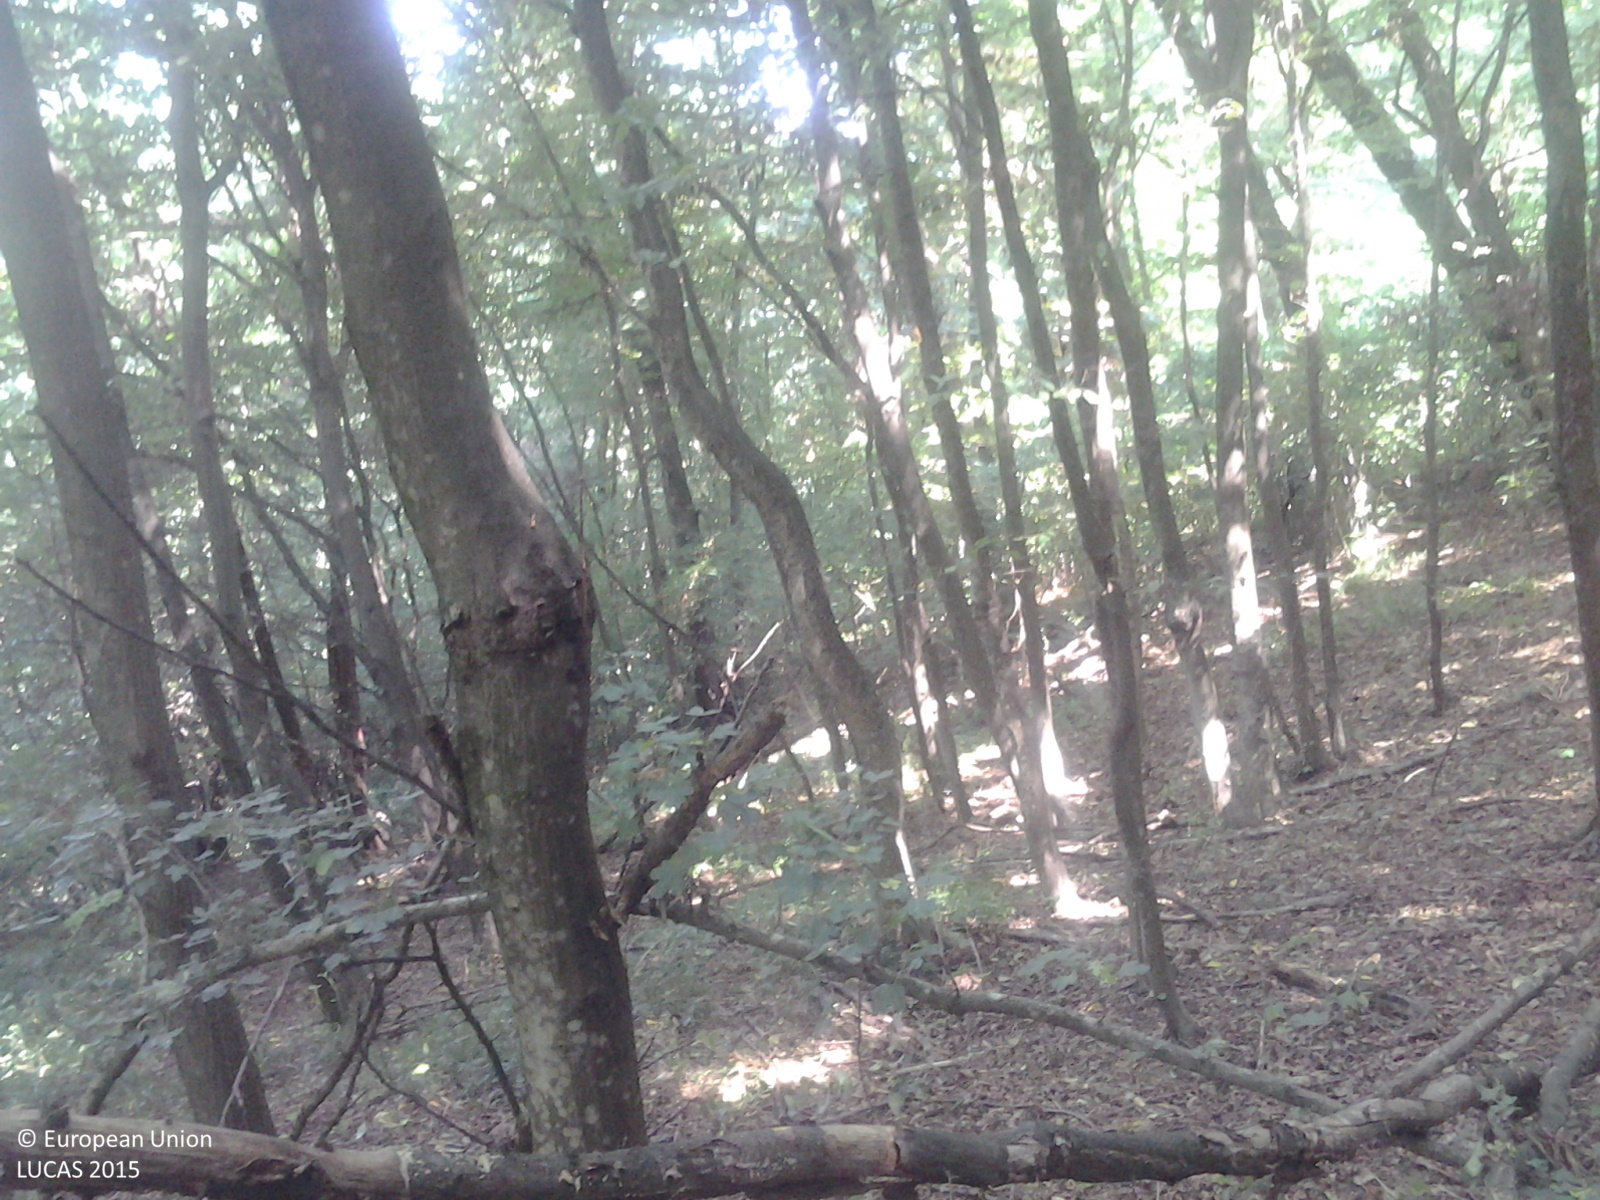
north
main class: Woodland
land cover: Broadleaved woodland
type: beech forest
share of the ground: > 75 %
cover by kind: broadleaved forest trees 100 %
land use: Forestry
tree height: > 5 m
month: August
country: HU
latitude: 46.5679
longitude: 17.0877
